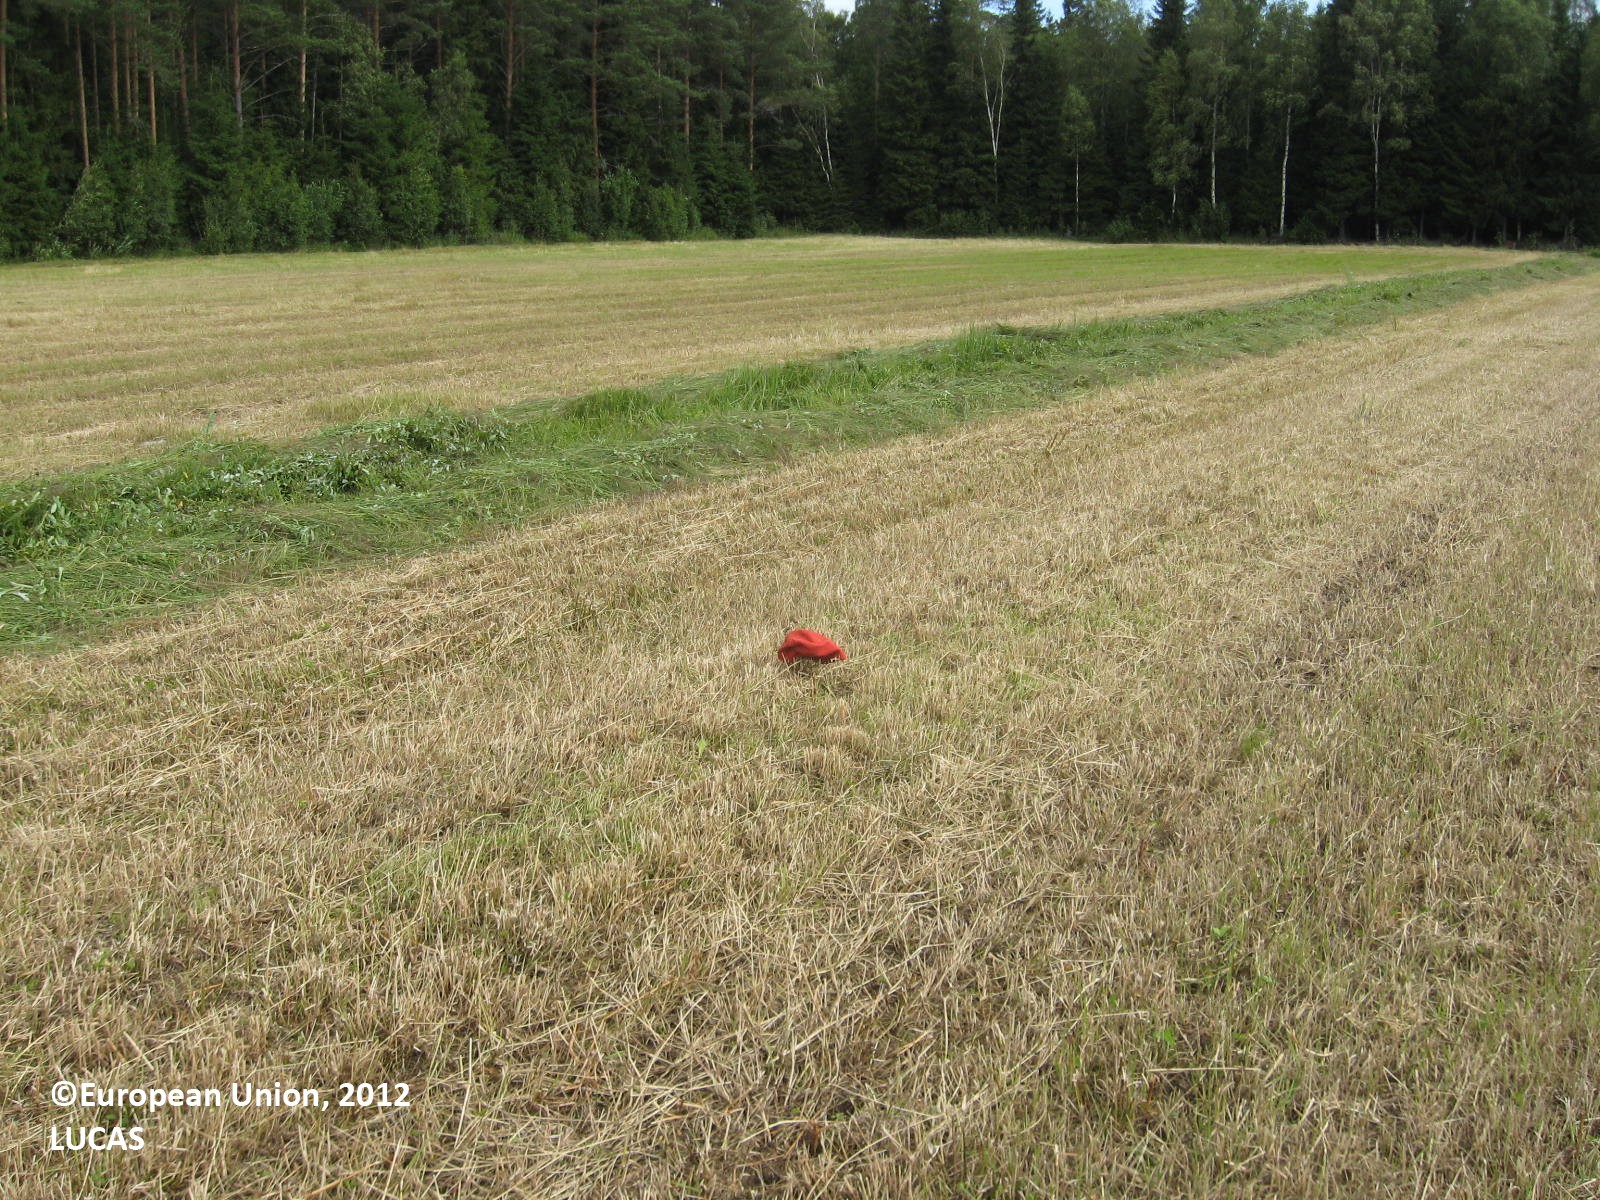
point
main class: Cropland
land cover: Temporary grasslands
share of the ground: > 75 %
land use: Agriculture (excluding fallow land and kitchen gardens)
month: July
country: FI
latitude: 61.9864
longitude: 21.5175
